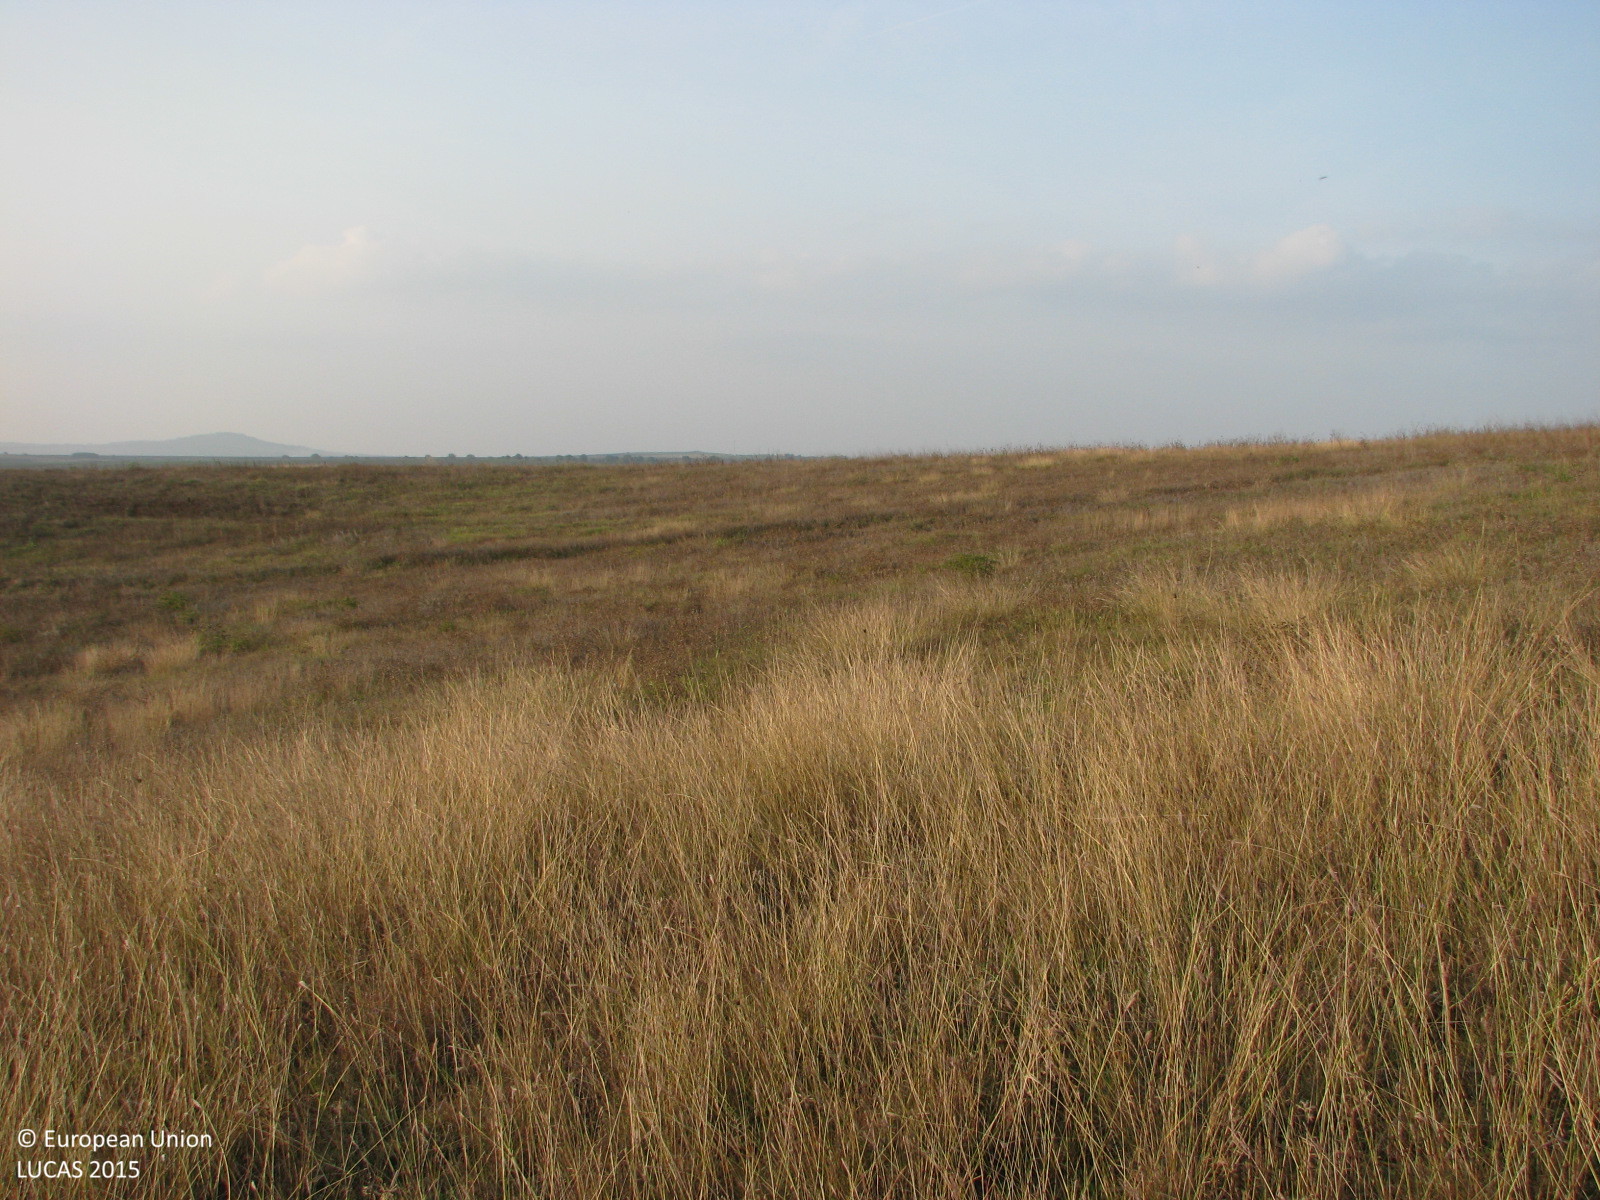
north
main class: Grassland
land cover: Grassland without tree/shrub cover
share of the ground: > 75 %
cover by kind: herbaceous plants 100 %
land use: Agriculture (excluding fallow land and kitchen gardens)
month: October
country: BG
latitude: 42.2954
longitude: 26.4257
